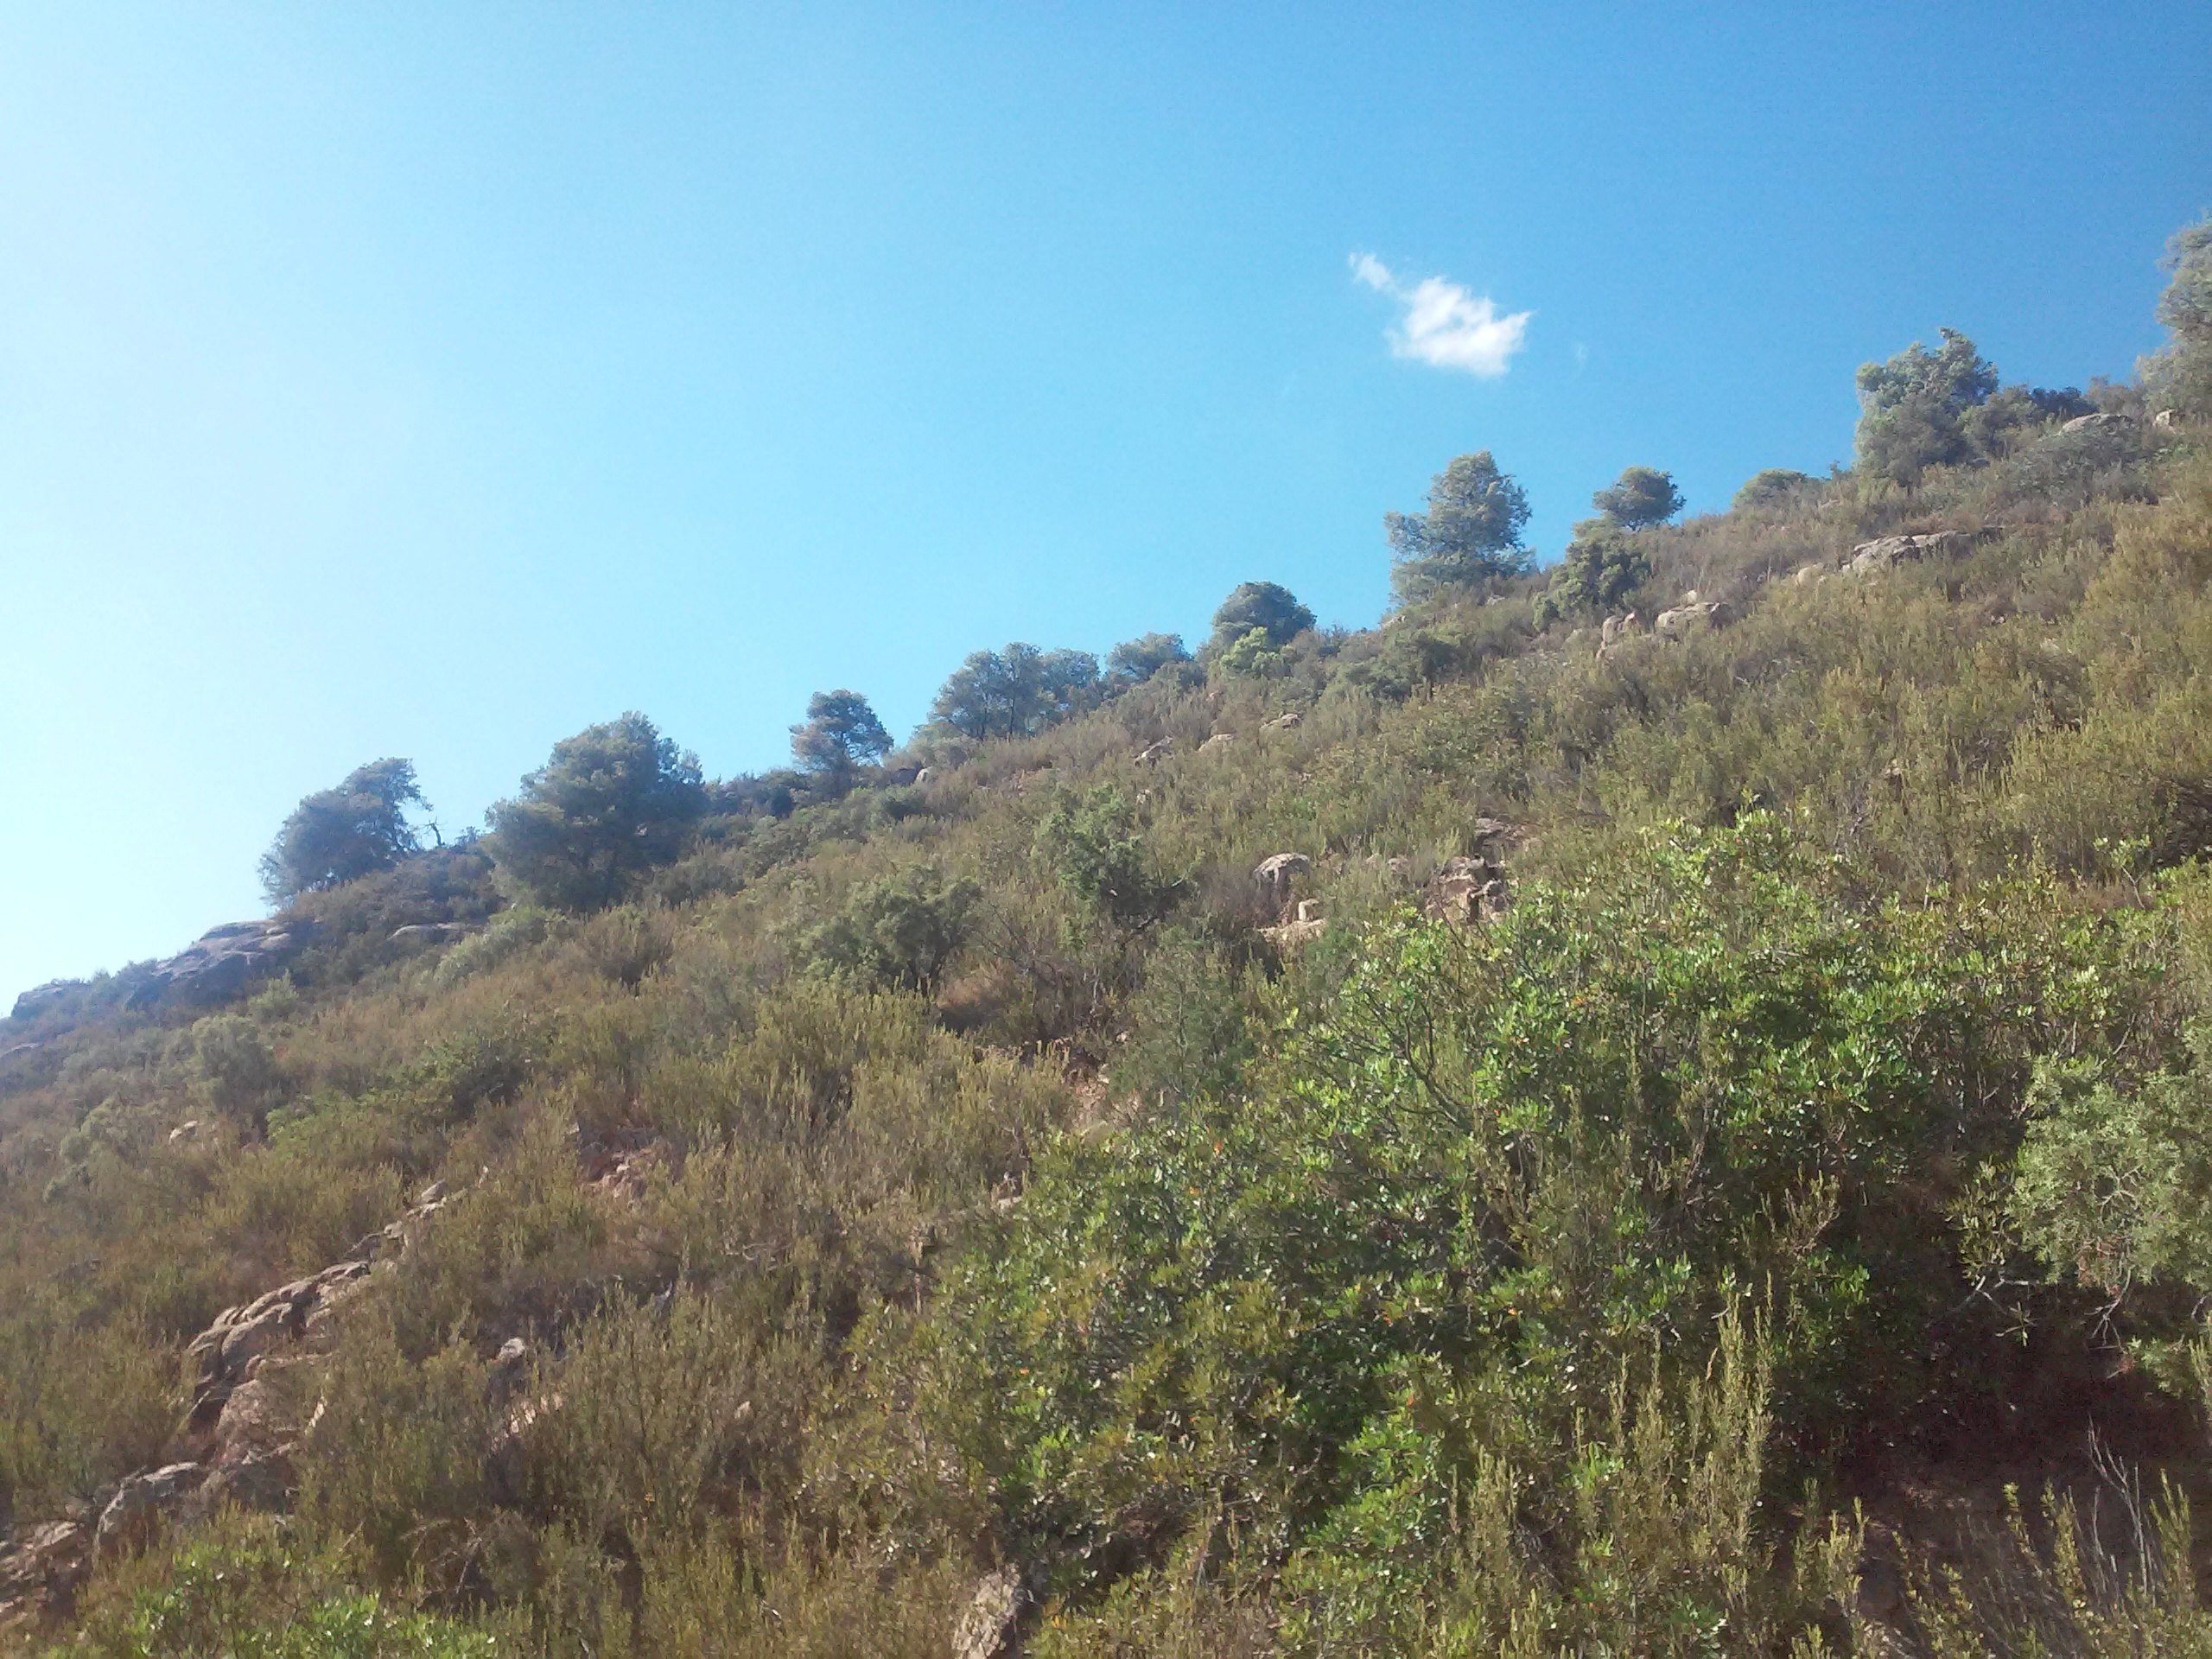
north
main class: Shrubland
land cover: Shrubland with sparse tree cover
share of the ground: 50 - 75 %
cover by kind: shrubs 60 %, herbaceous plants 30 %, coniferous forest trees 5 %, consolidated bare surface 5 %
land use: Semi-natural and natural areas not in use
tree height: < 5 m
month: August
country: ES
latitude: 41.3196
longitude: 0.5401
